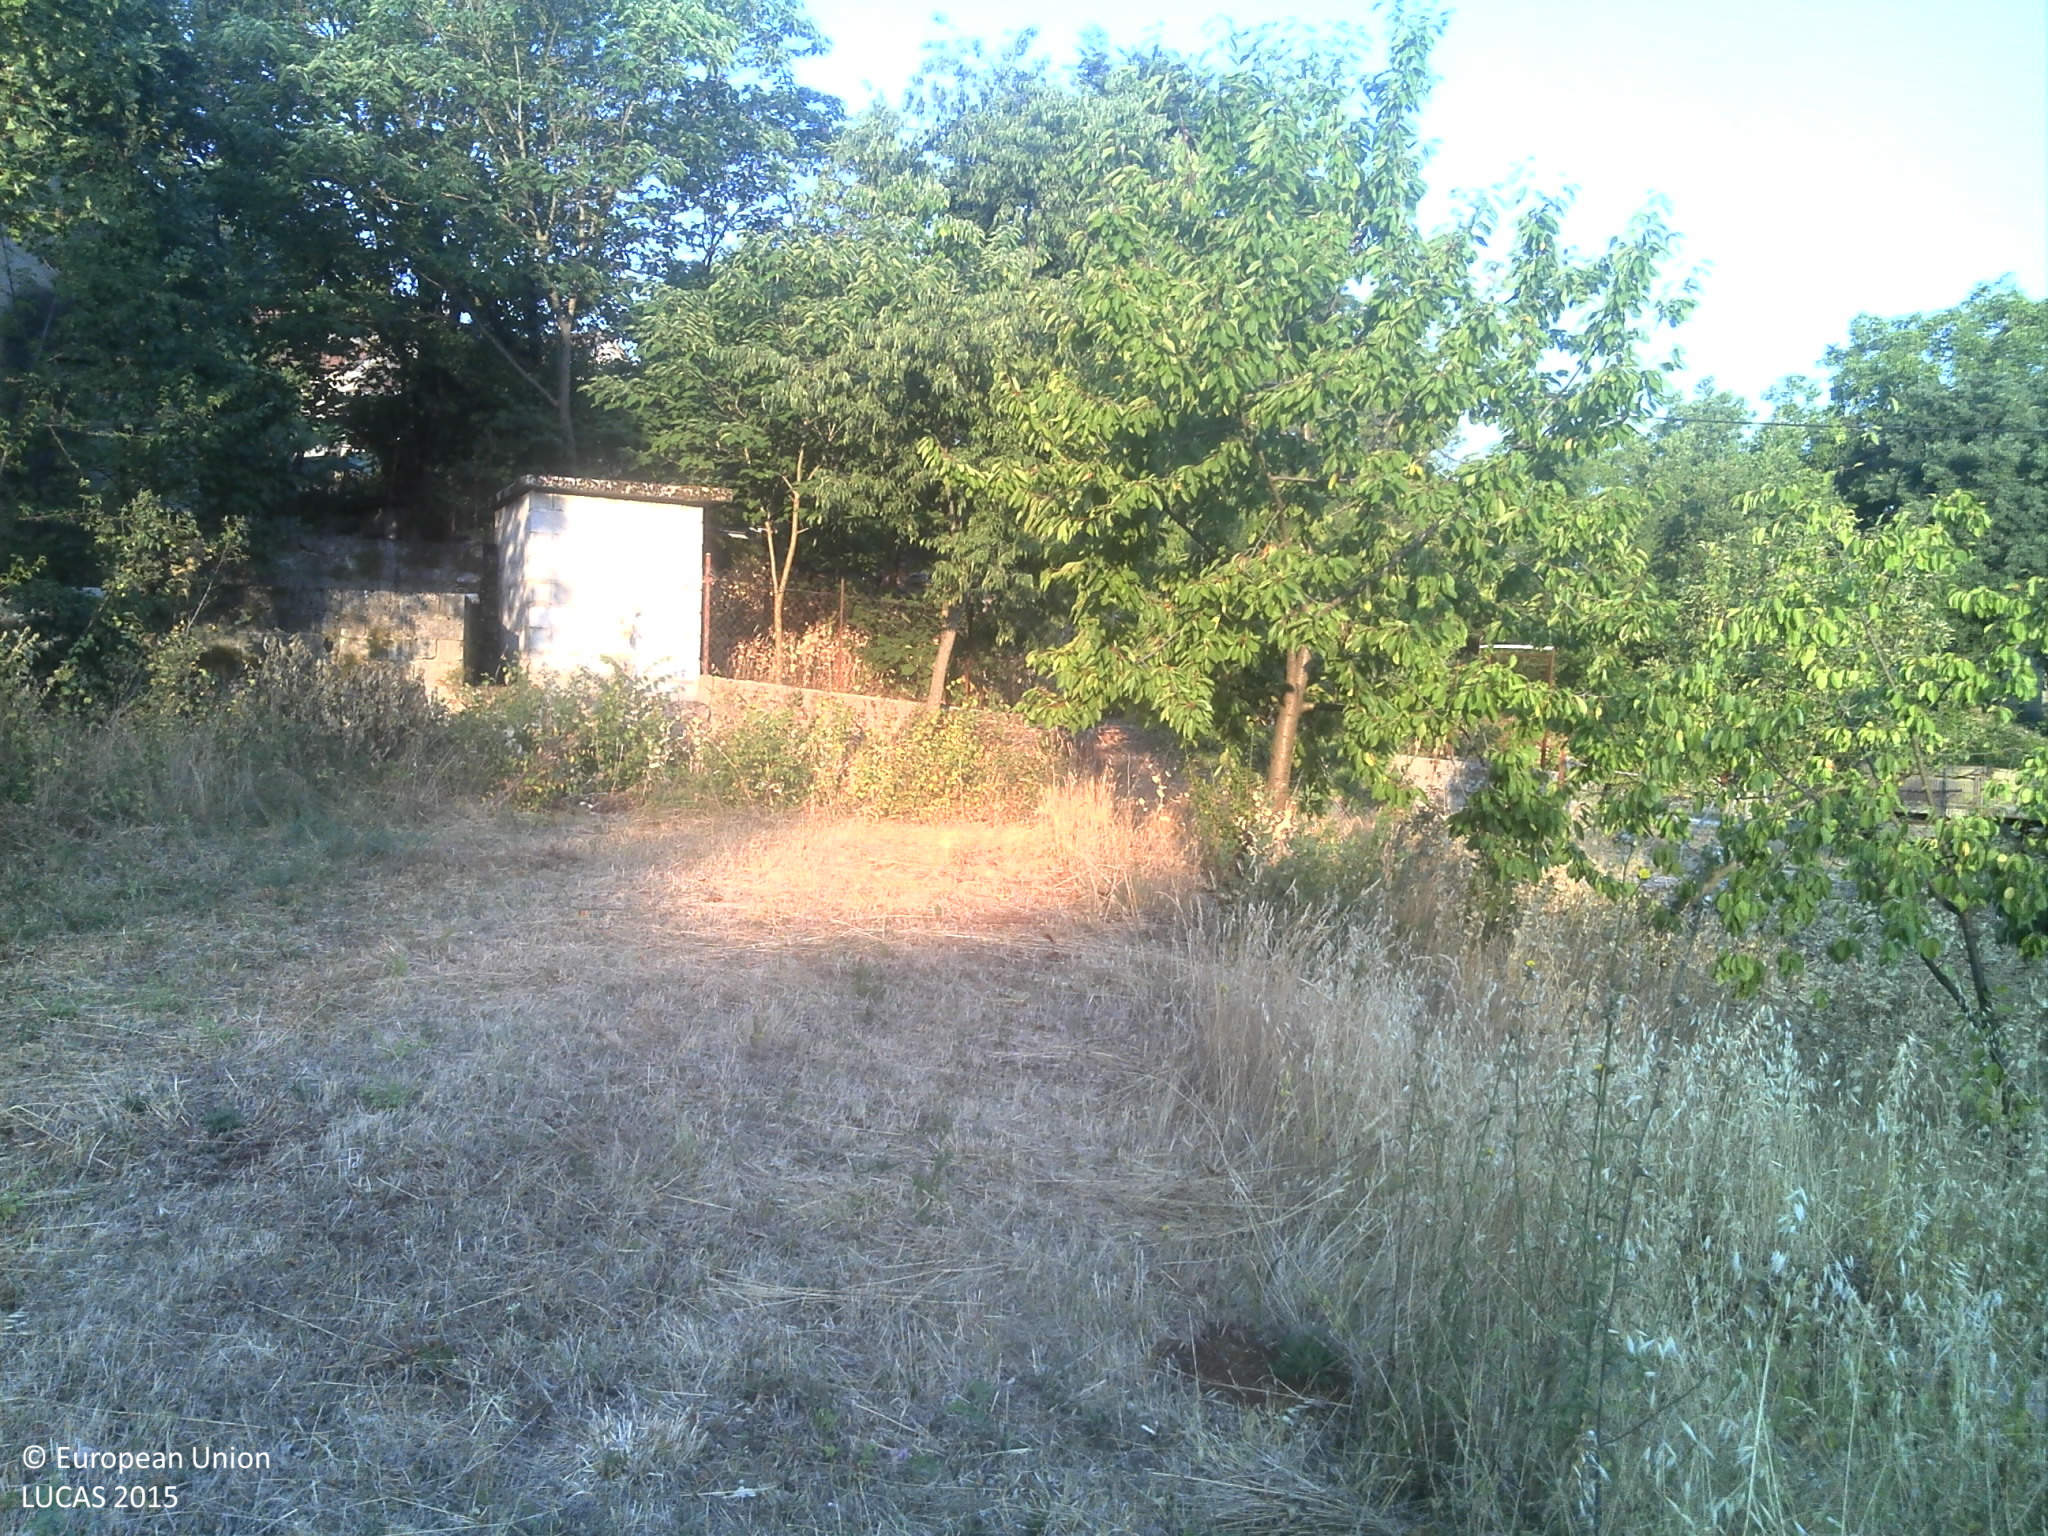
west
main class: Grassland
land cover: Grassland without tree/shrub cover
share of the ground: > 75 %
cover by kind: herbaceous plants 95 %, shrubs 5 %
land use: Agriculture (excluding fallow land and kitchen gardens)
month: July
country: HR
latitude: 43.4145
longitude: 17.1671
